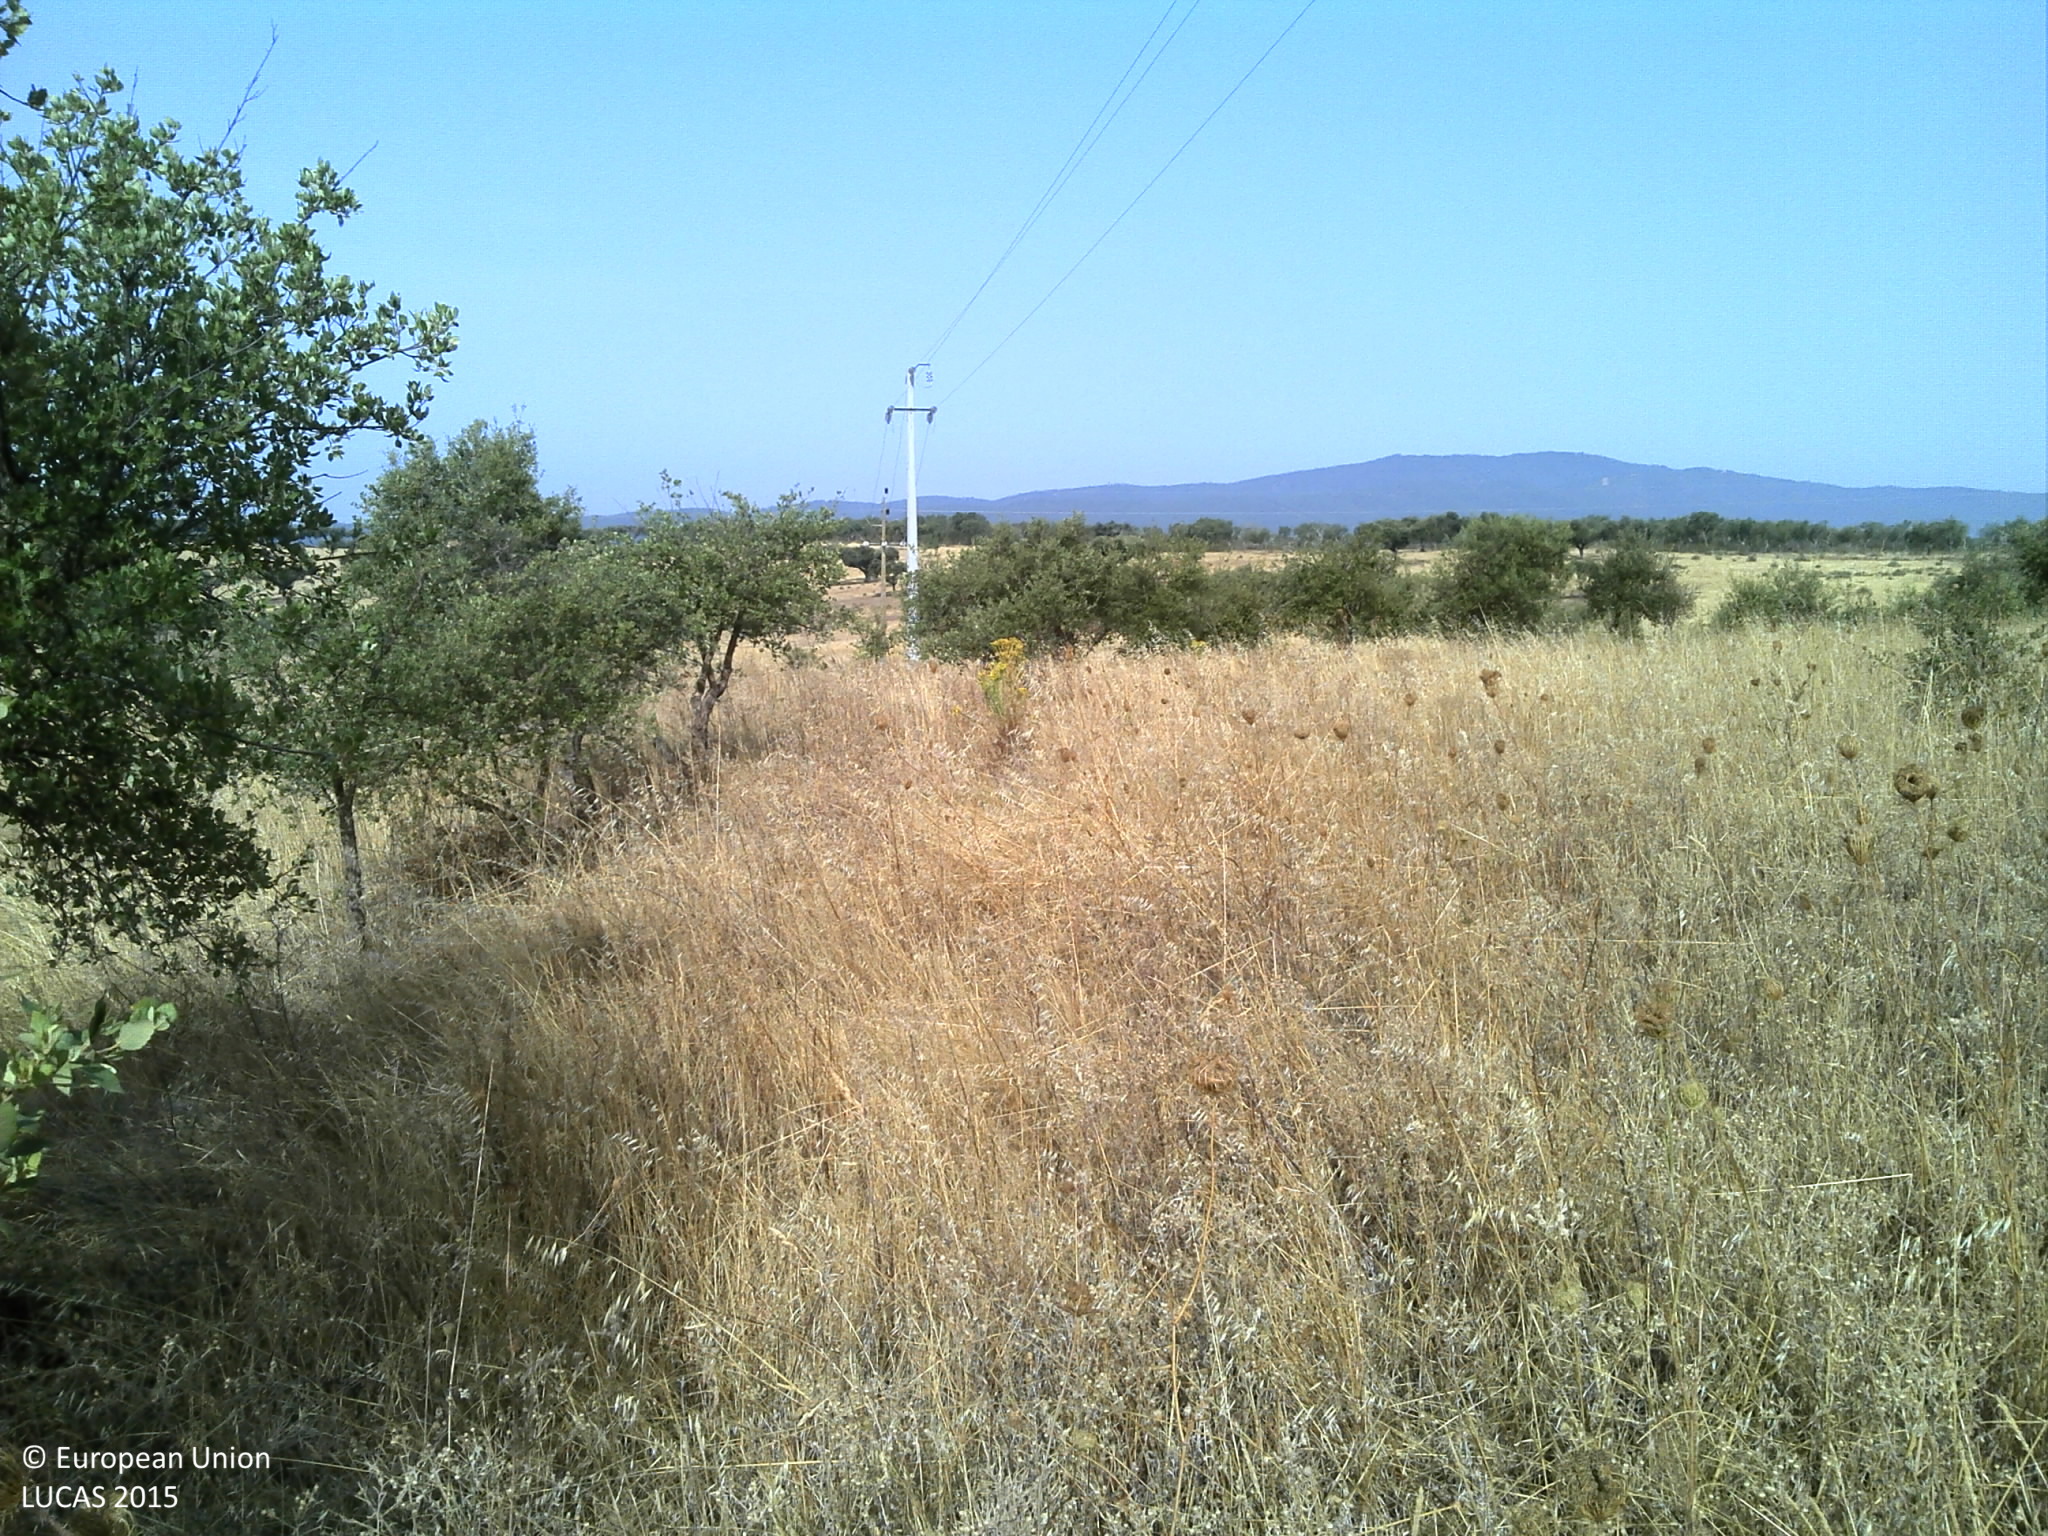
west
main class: Woodland
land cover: Broadleaved woodland
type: broadleaved evergreen forest
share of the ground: 10 - 25 %
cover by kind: herbaceous plants 60 %, unconsolidated bare surface 25 %, broadleaved forest trees 15 %
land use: Forestry
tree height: < 5 m
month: July
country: PT
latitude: 38.7253
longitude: -7.4578
